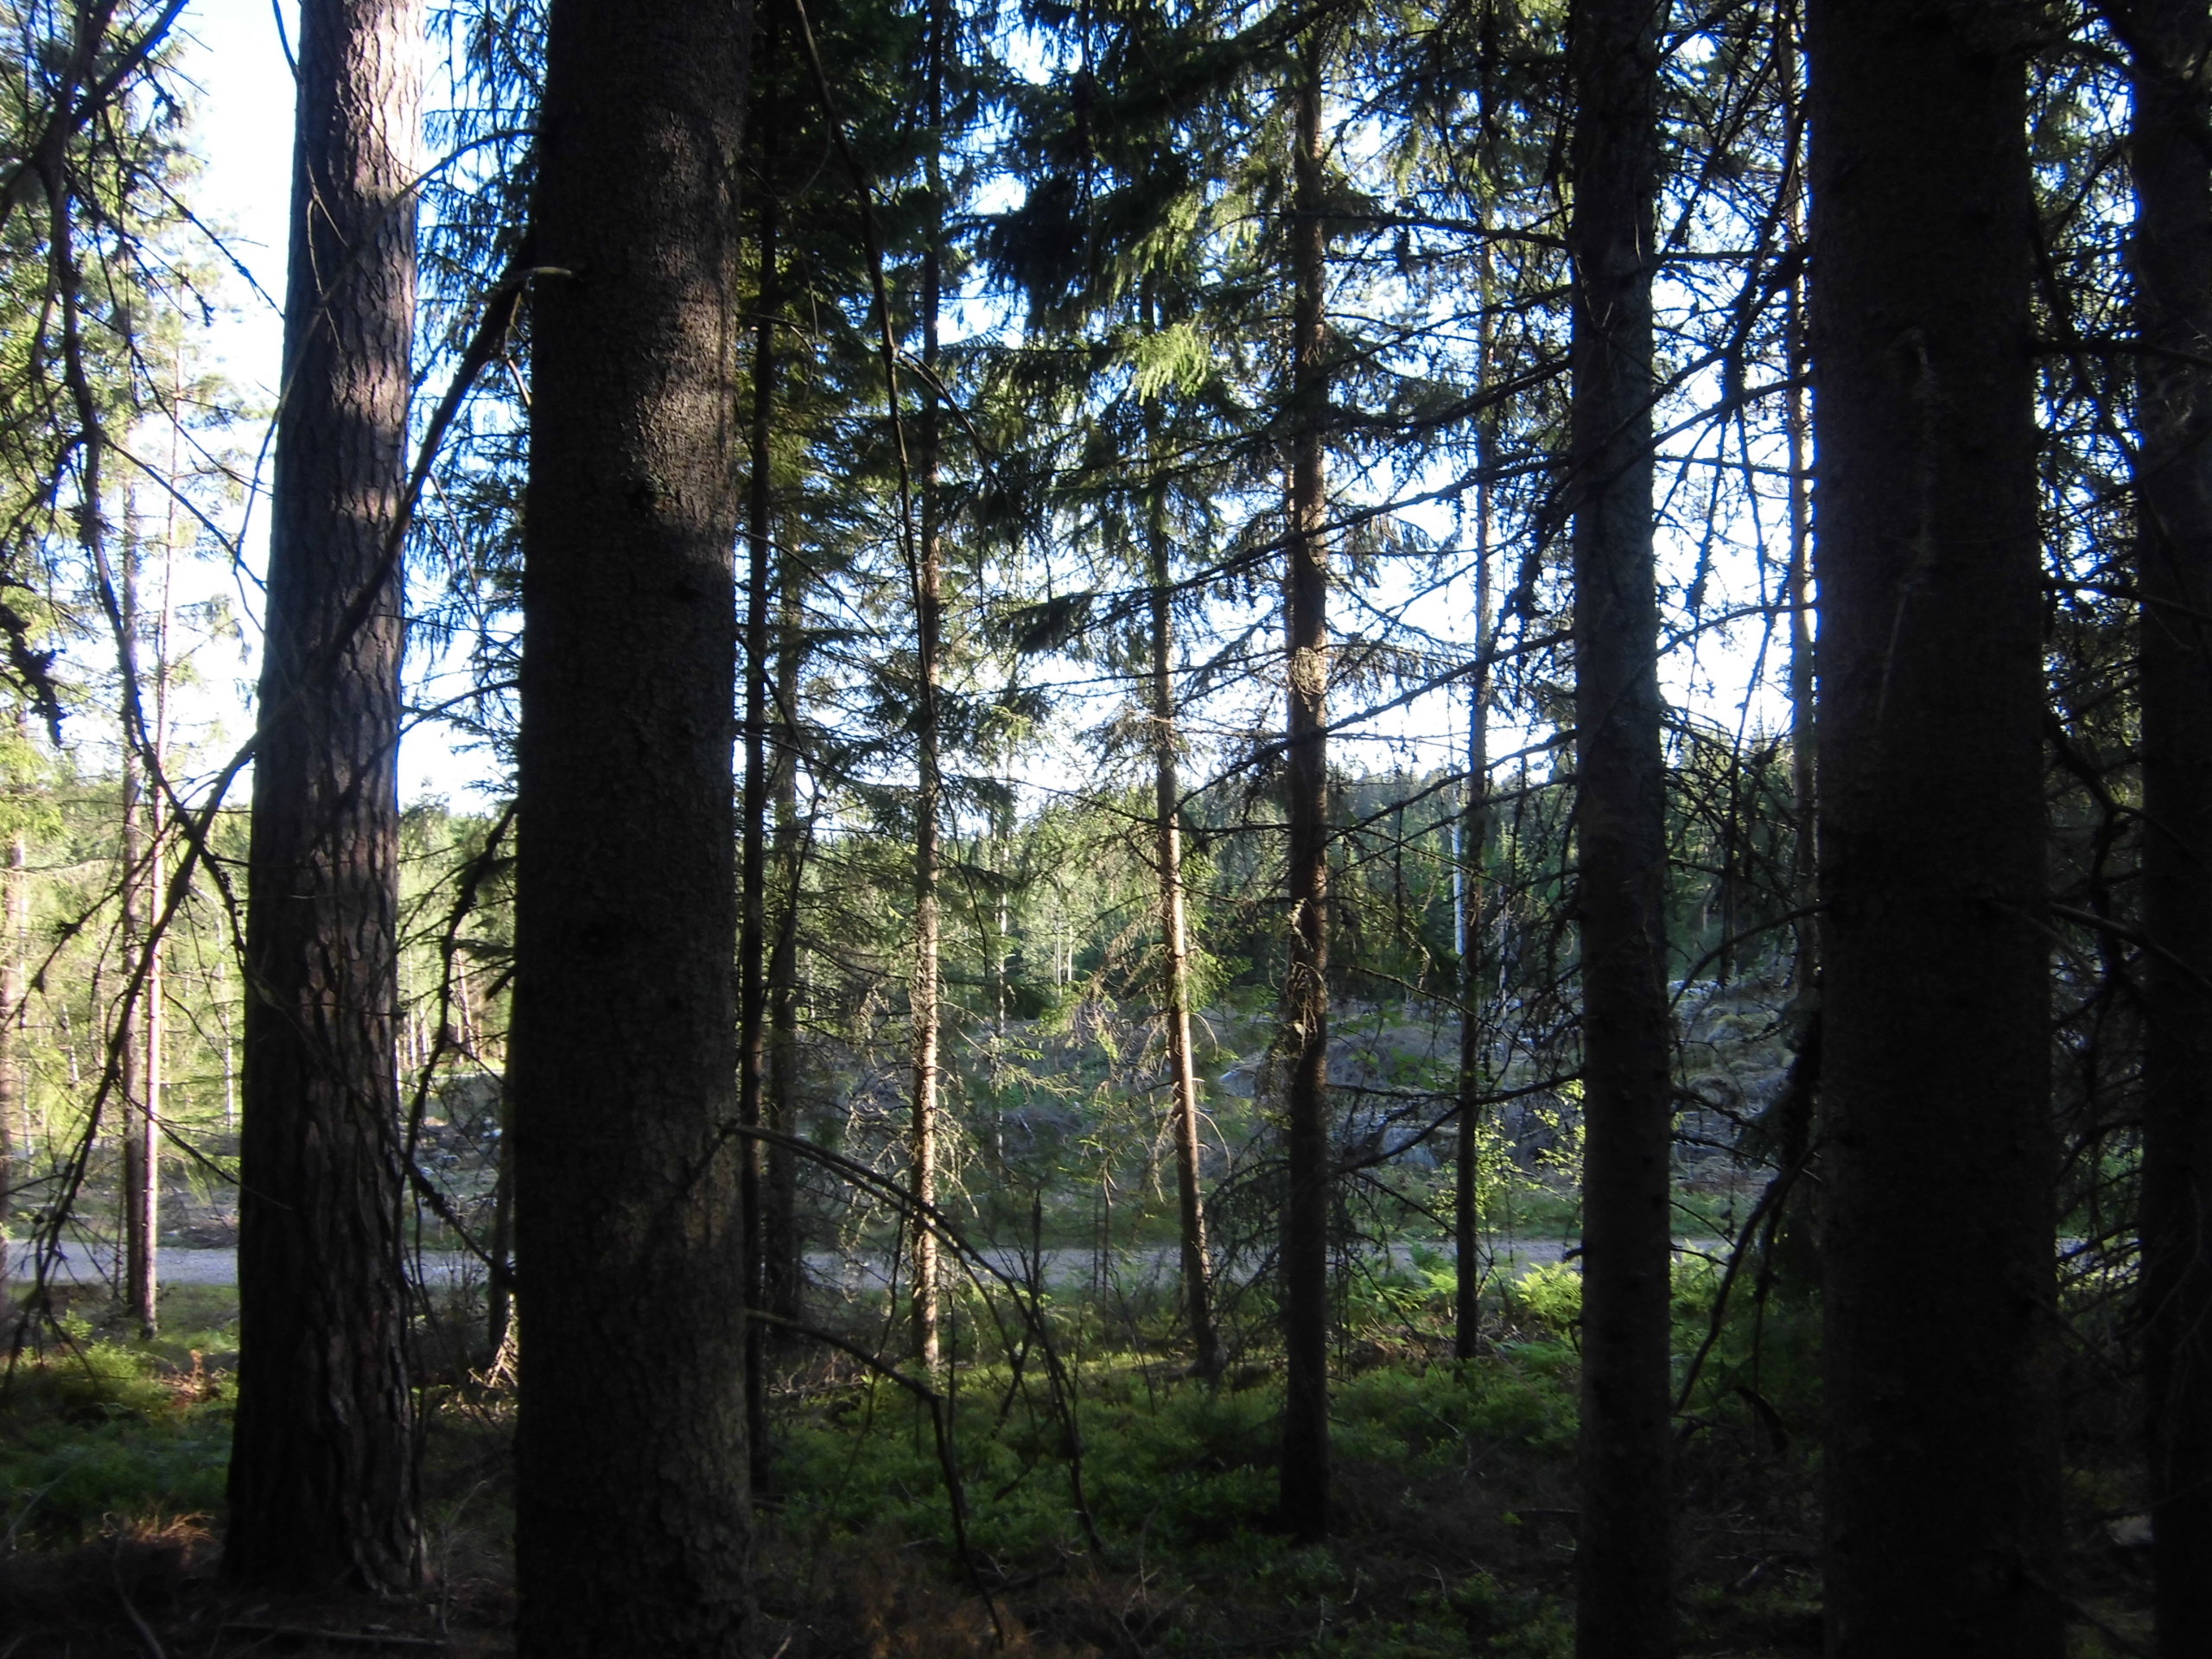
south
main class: Woodland
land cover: Spruce dominated coniferous woodland
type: boreal forest
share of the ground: 50 - 75 %
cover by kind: coniferous forest trees 70 %, lichens and mosses 15 %, shrubs 10 %, herbaceous plants 5 %
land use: Forestry
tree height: > 5 m
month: July
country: SE
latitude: 57.2491
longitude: 15.3172
